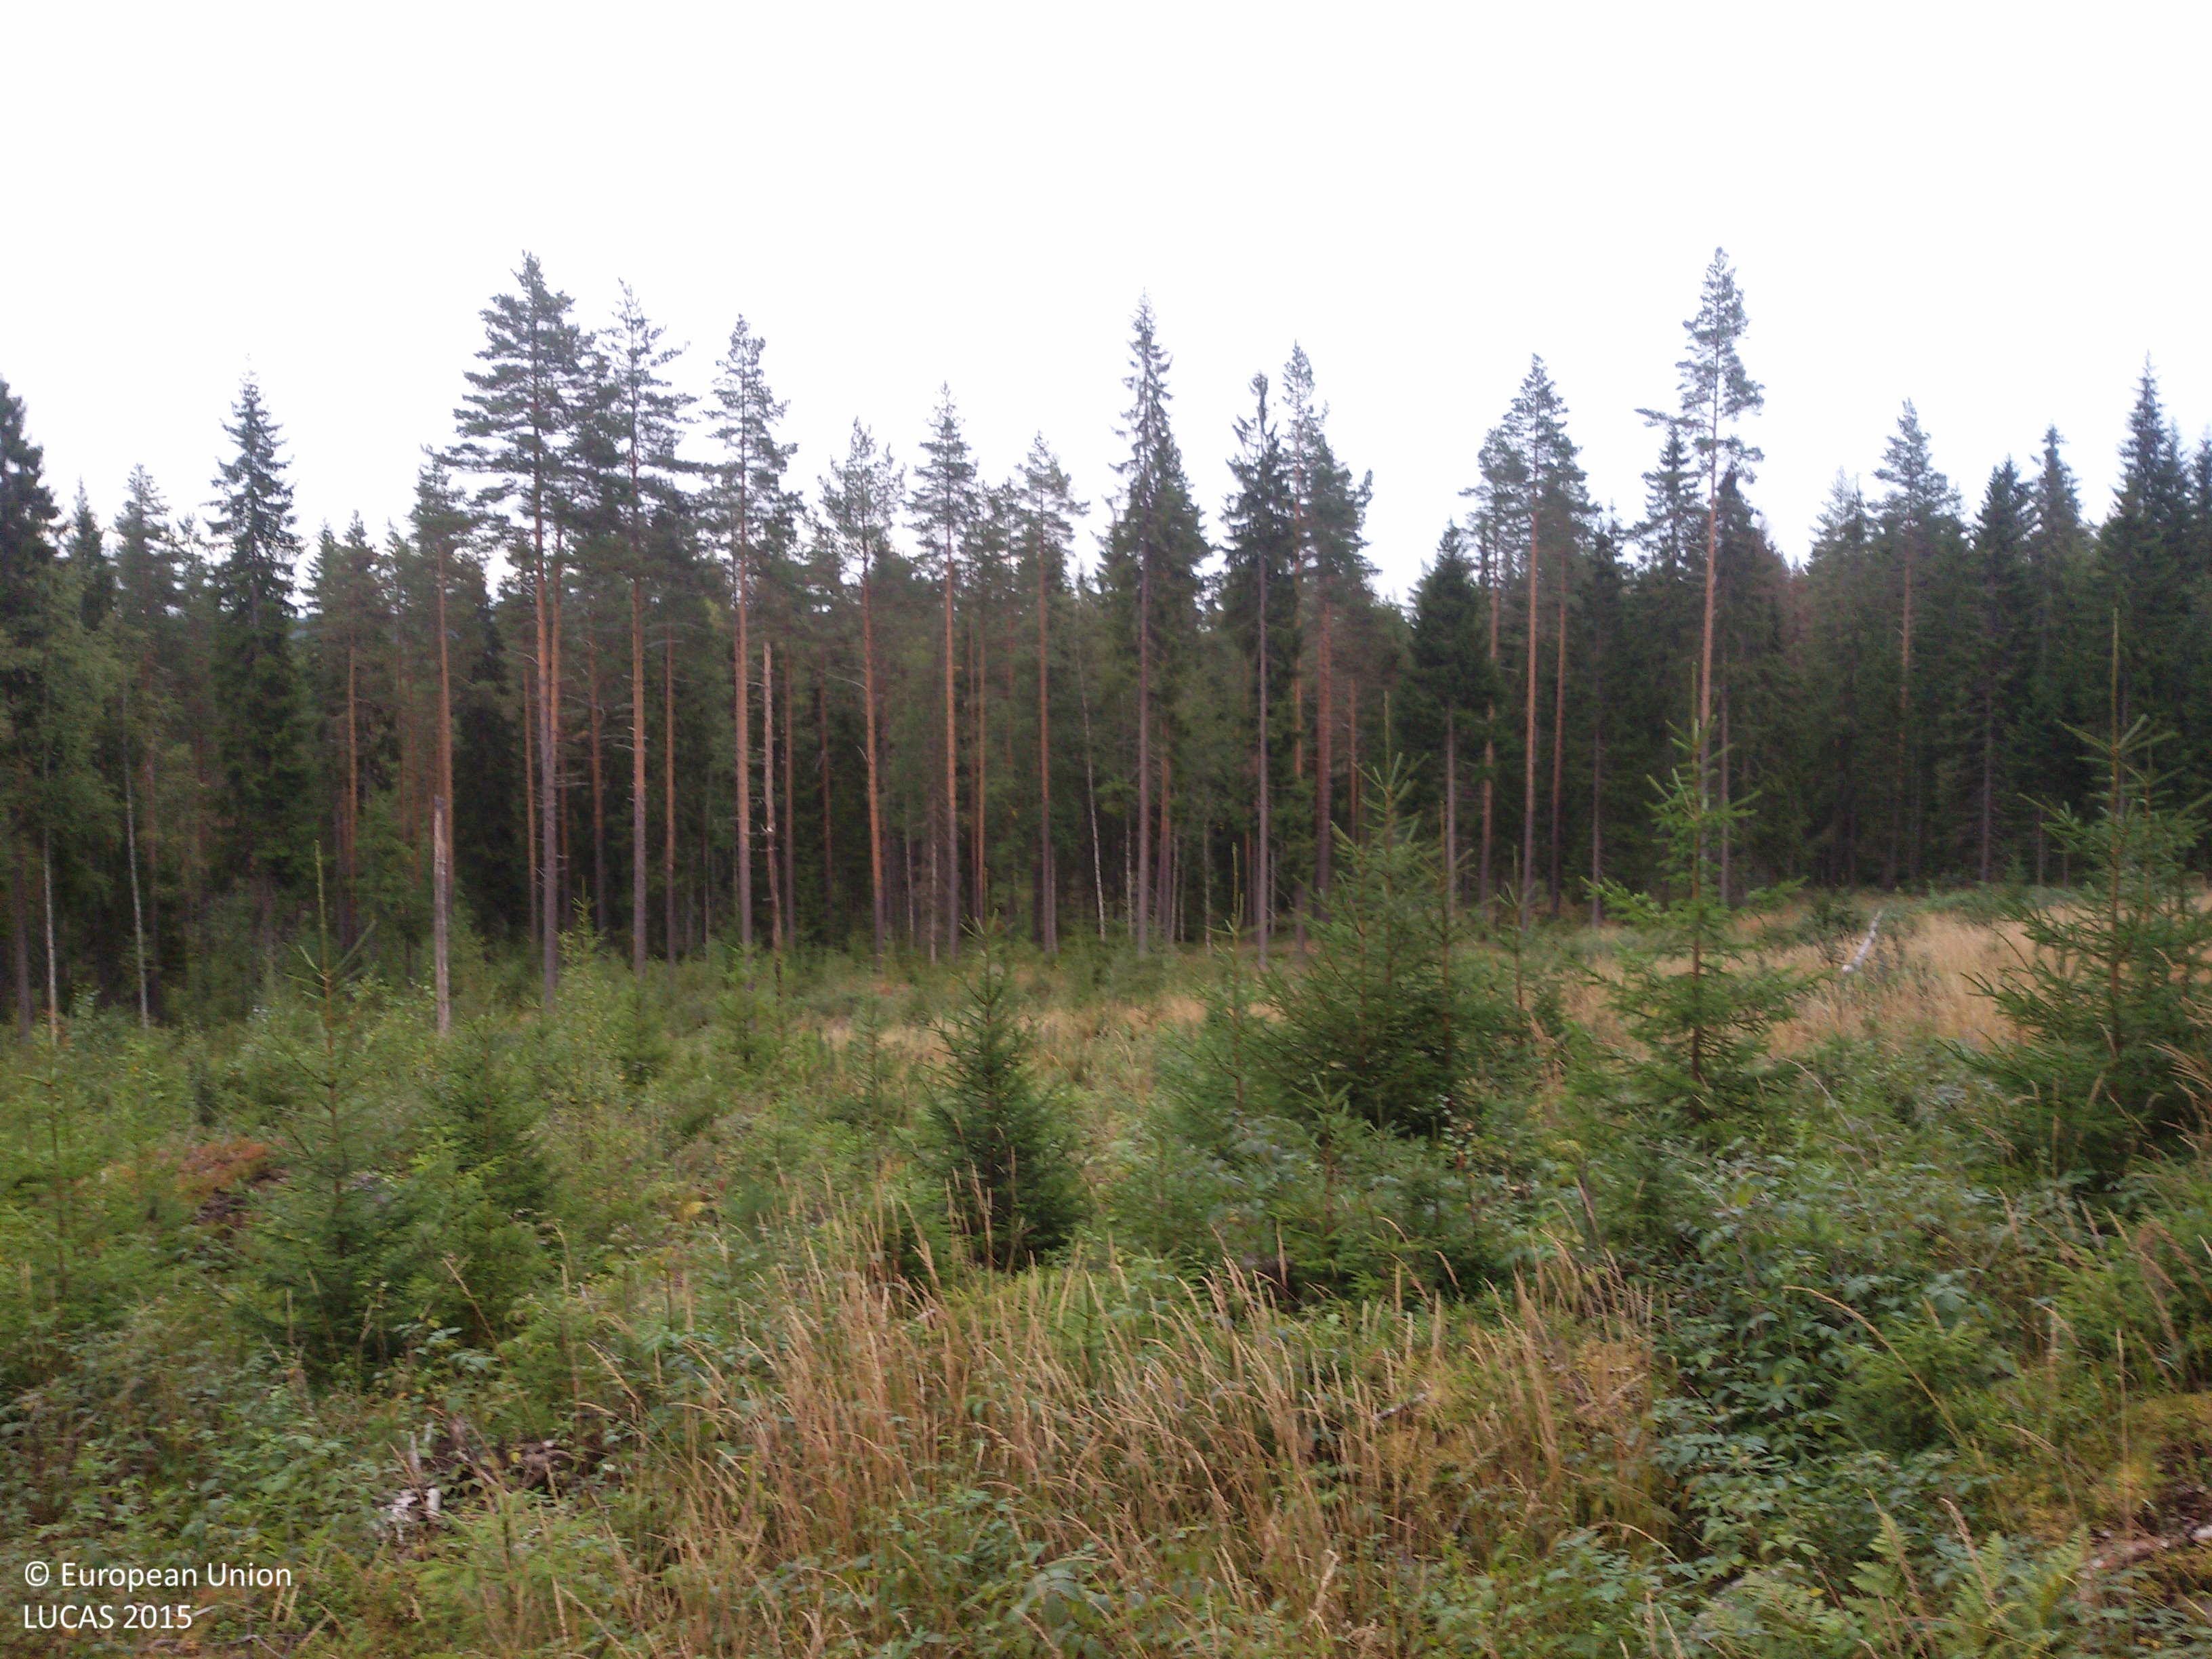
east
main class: Woodland
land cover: Spruce dominated coniferous woodland
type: boreal forest
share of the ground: 10 - 25 %
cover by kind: herbaceous plants 70 %, coniferous forest trees 20 %
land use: Forestry
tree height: > 5 m
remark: Nursery
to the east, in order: Spruce dominated coniferous woodland; Pine dominated coniferous woodland; Electric lines; Pine dominated mixed woodland; Dry stone walls
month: September
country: SE
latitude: 60.9327
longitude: 15.6877
